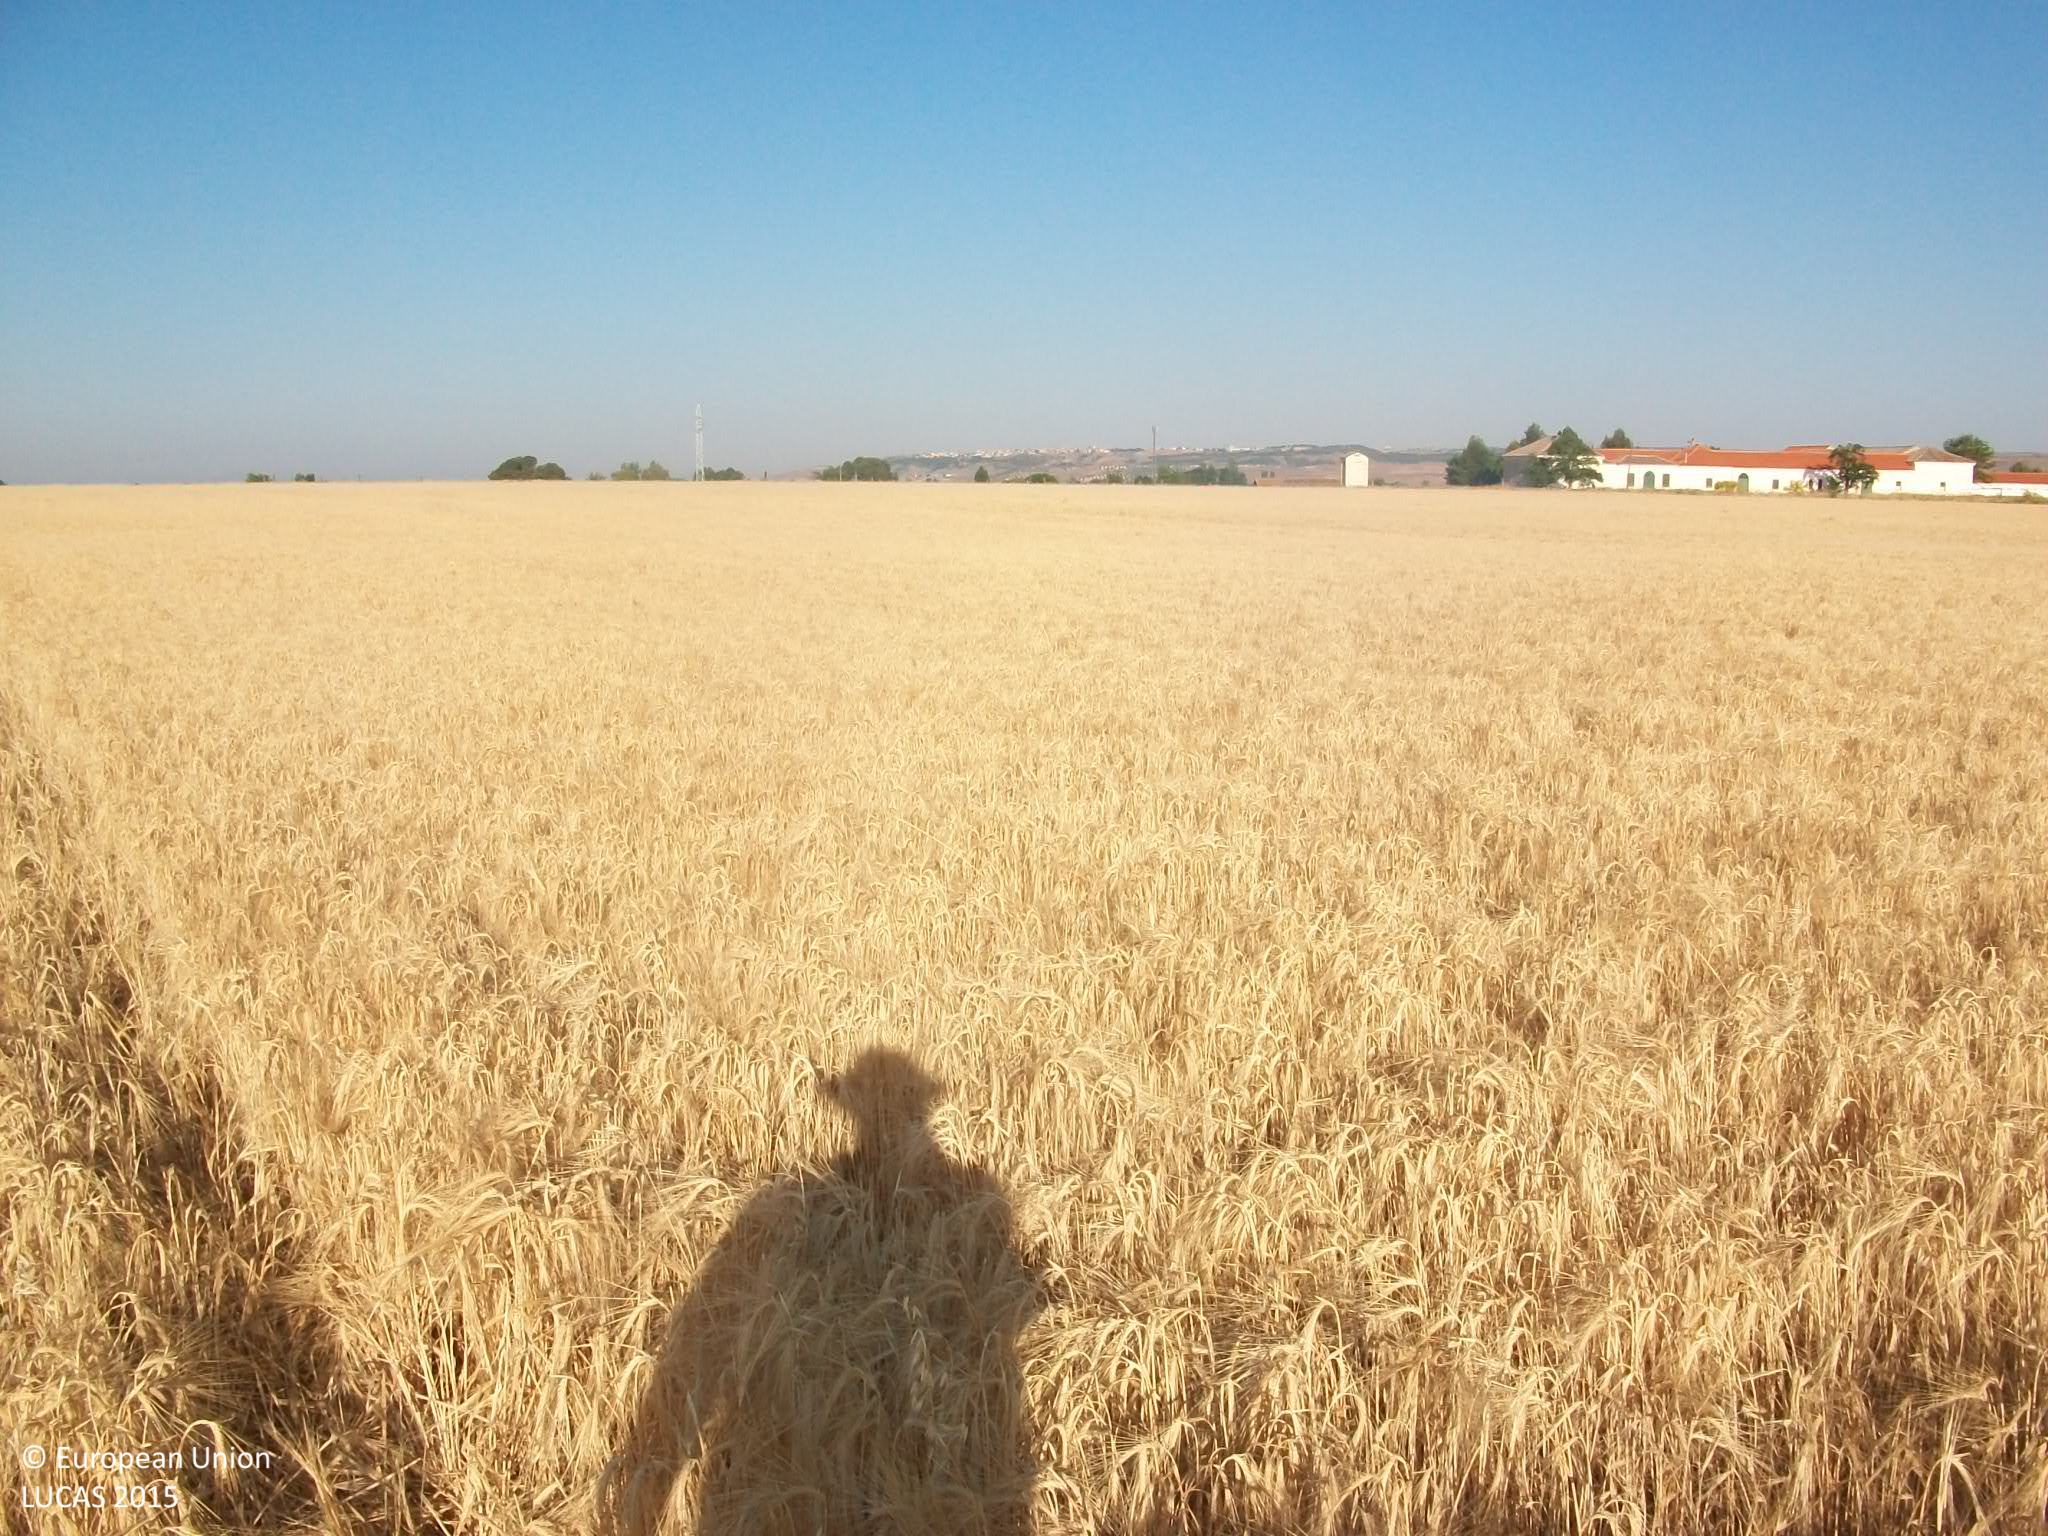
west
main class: Cropland
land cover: Barley
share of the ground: > 75 %
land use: Agriculture (excluding fallow land and kitchen gardens)
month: May
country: ES
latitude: 40.0006
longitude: -3.6778
